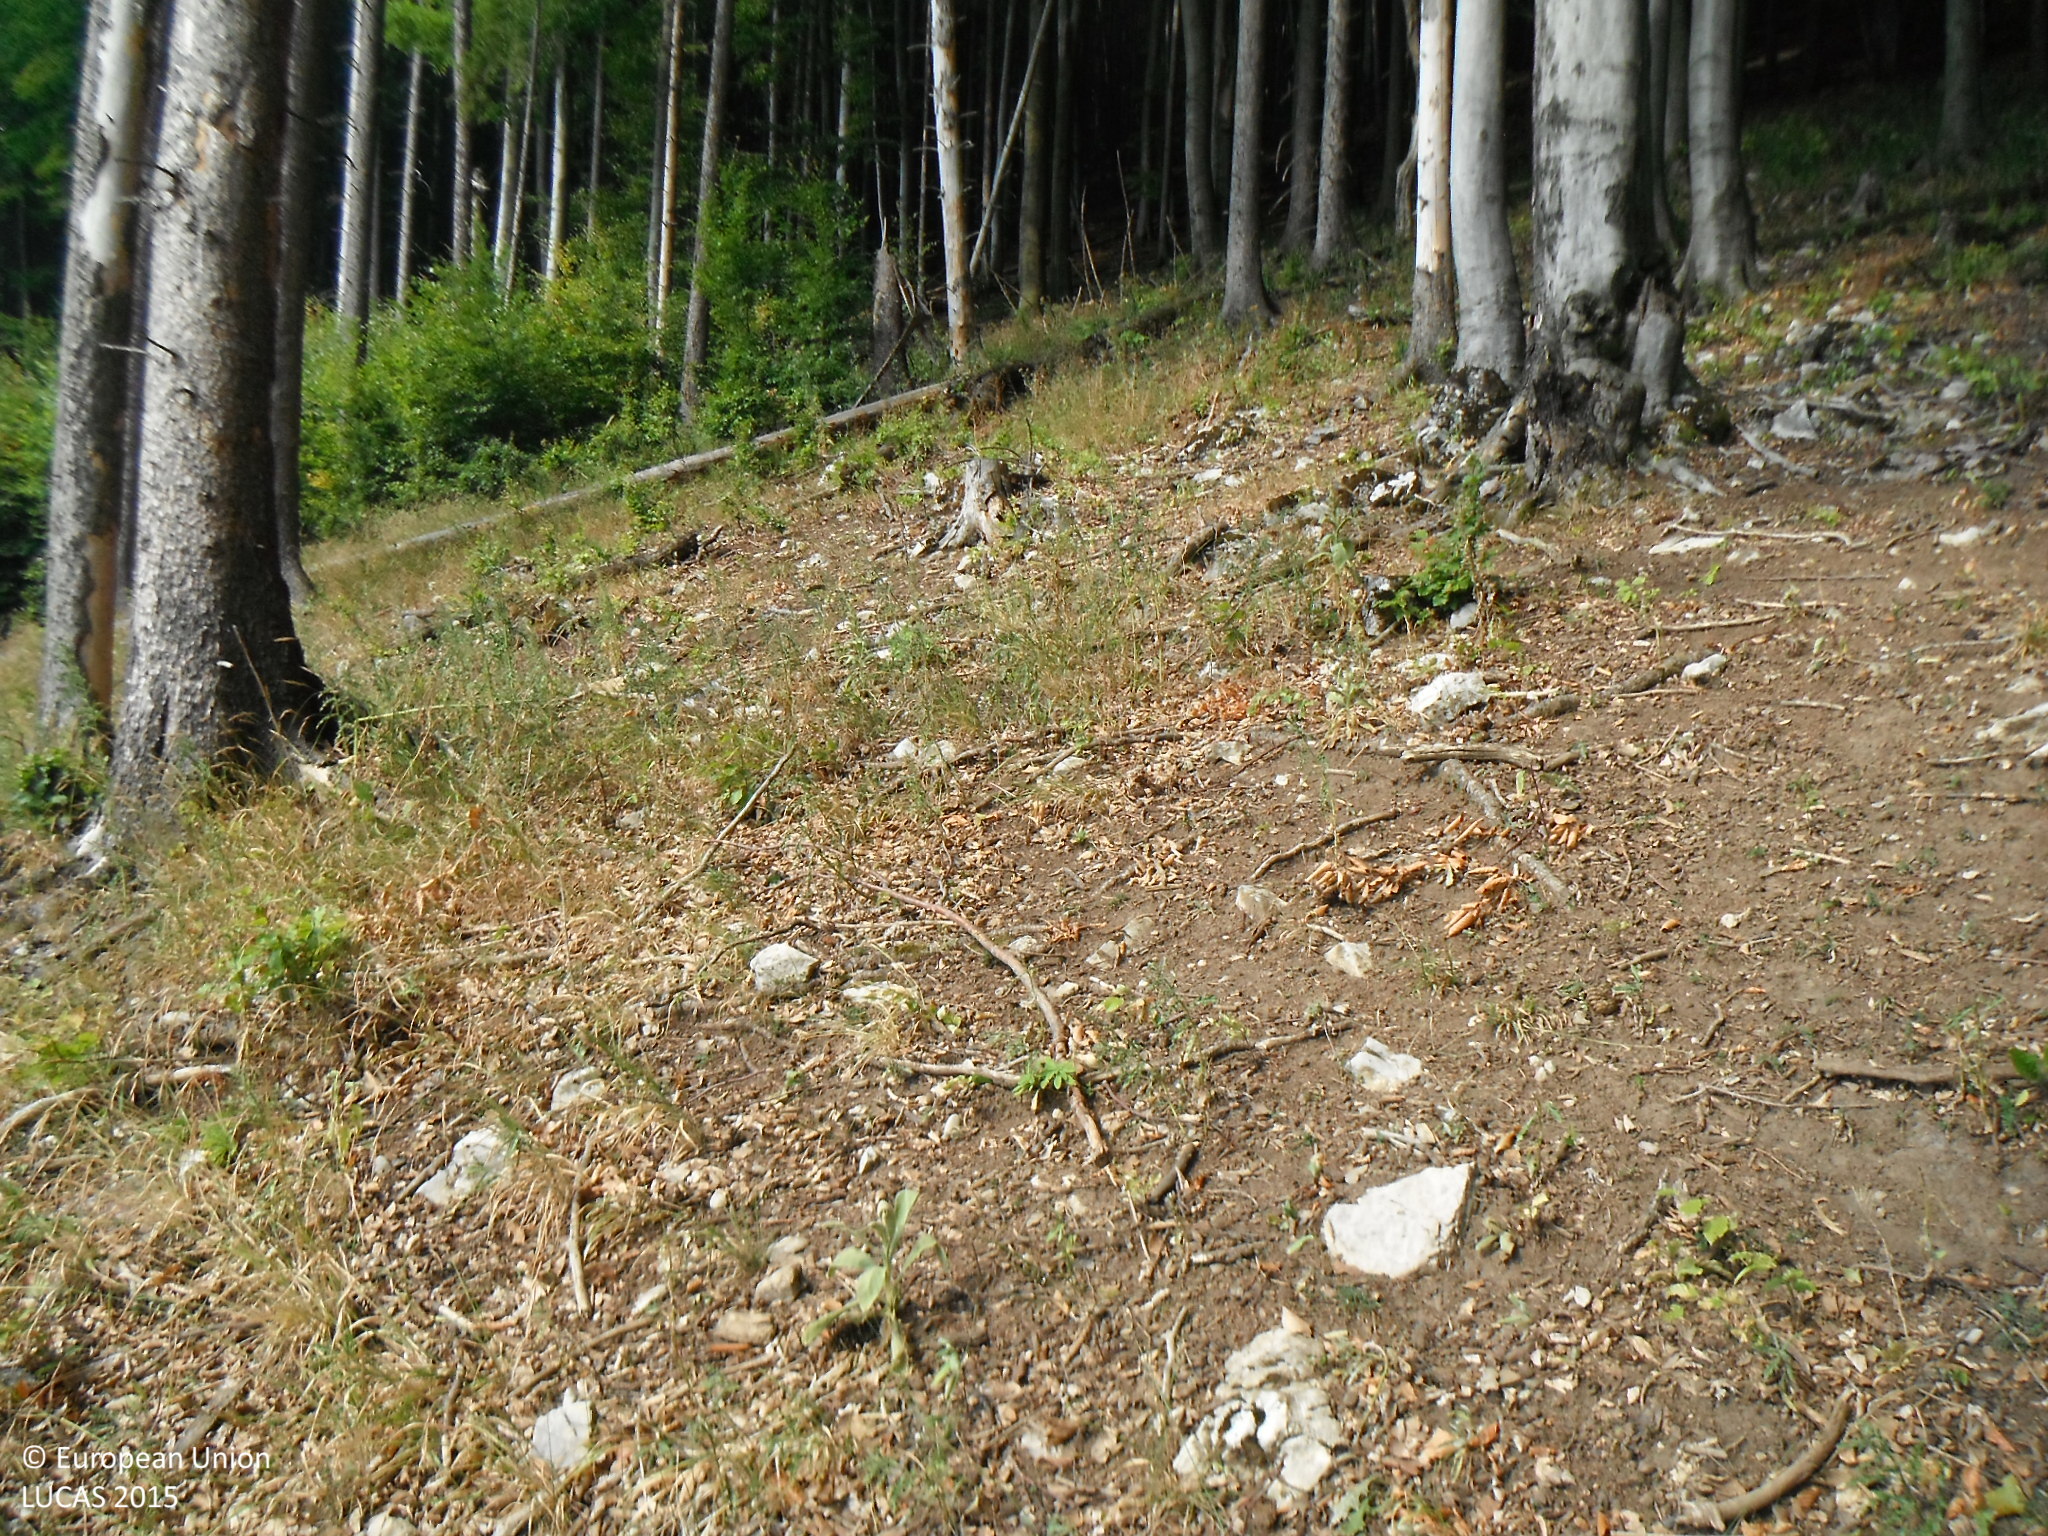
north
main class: Woodland
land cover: Spruce dominated mixed woodland
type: mesophytic deciduous forest
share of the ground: > 75 %
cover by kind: broadleaved forest trees 55 %, coniferous forest trees 25 %, herbaceous plants 15 %, unconsolidated bare surface 5 %
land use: Forestry
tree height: > 5 m
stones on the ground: 25 - 50 %
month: August
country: SK
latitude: 48.9566
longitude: 18.3336
